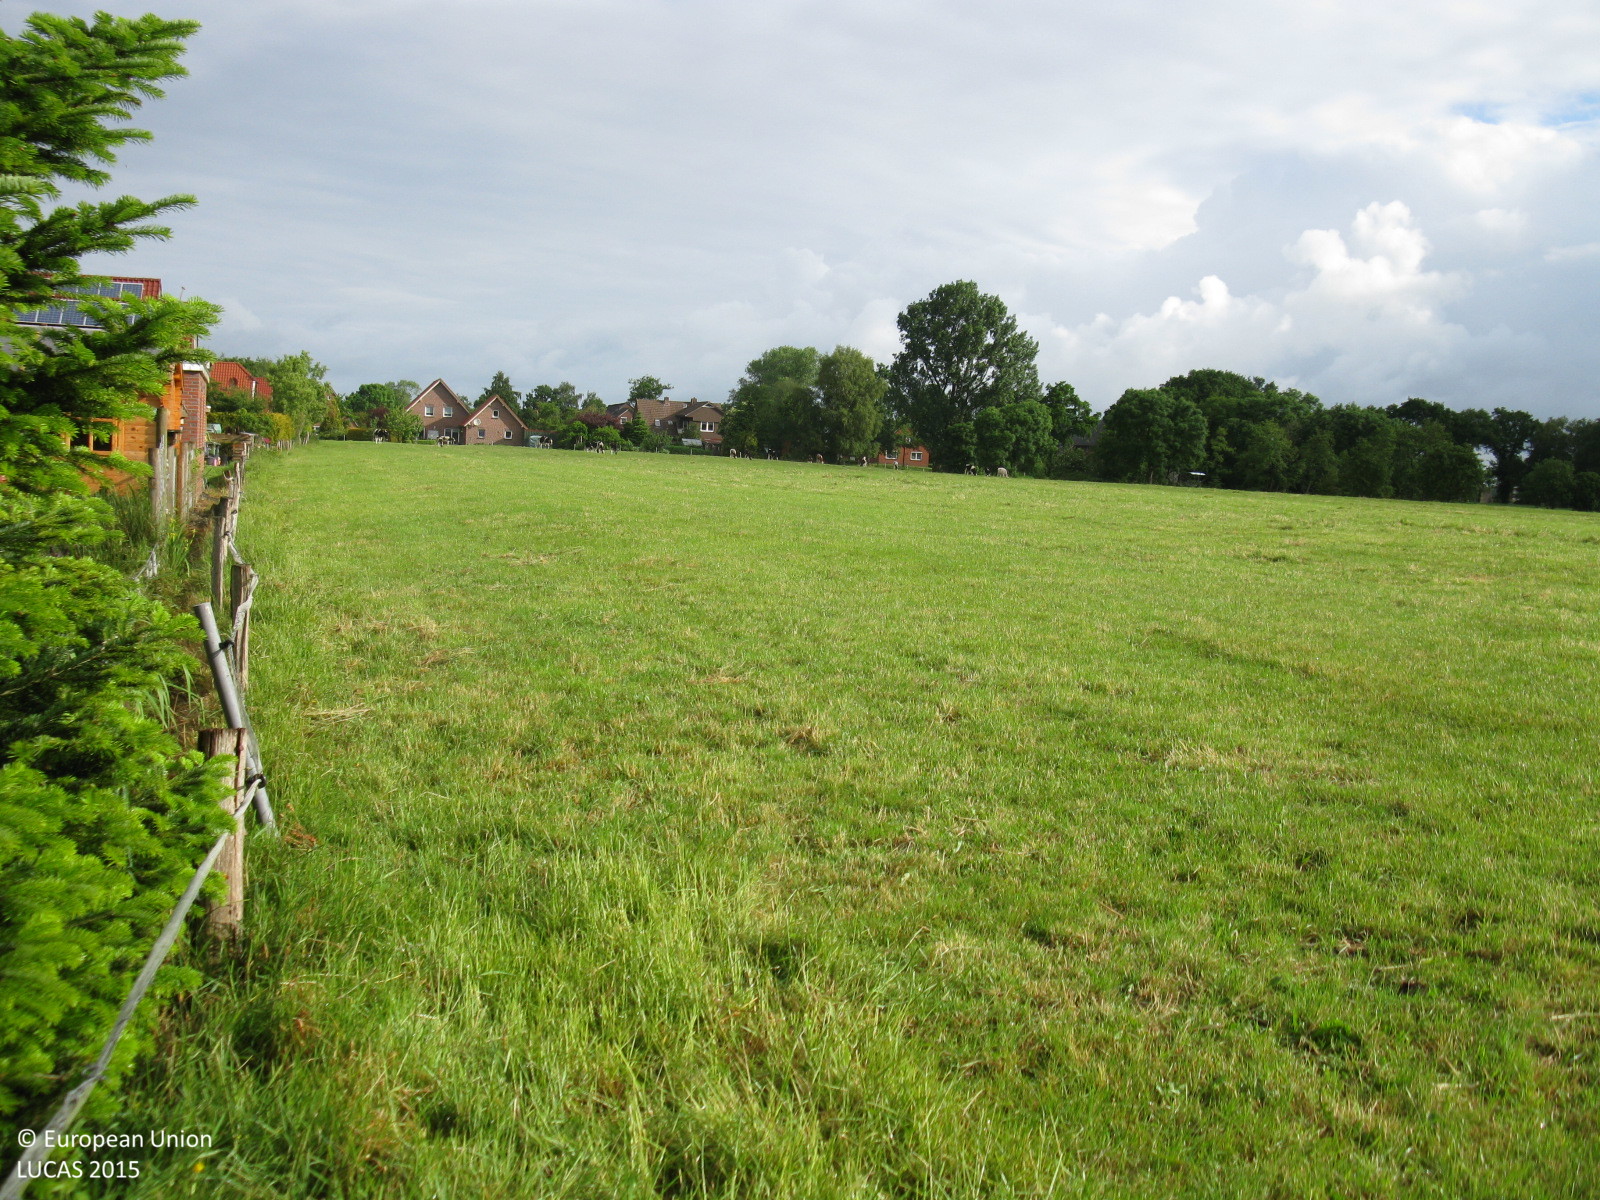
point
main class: Grassland
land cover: Grassland without tree/shrub cover
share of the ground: > 75 %
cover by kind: herbaceous plants 100 %
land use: Agriculture (excluding fallow land and kitchen gardens)
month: June
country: DE
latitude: 53.4985
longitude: 7.3324
